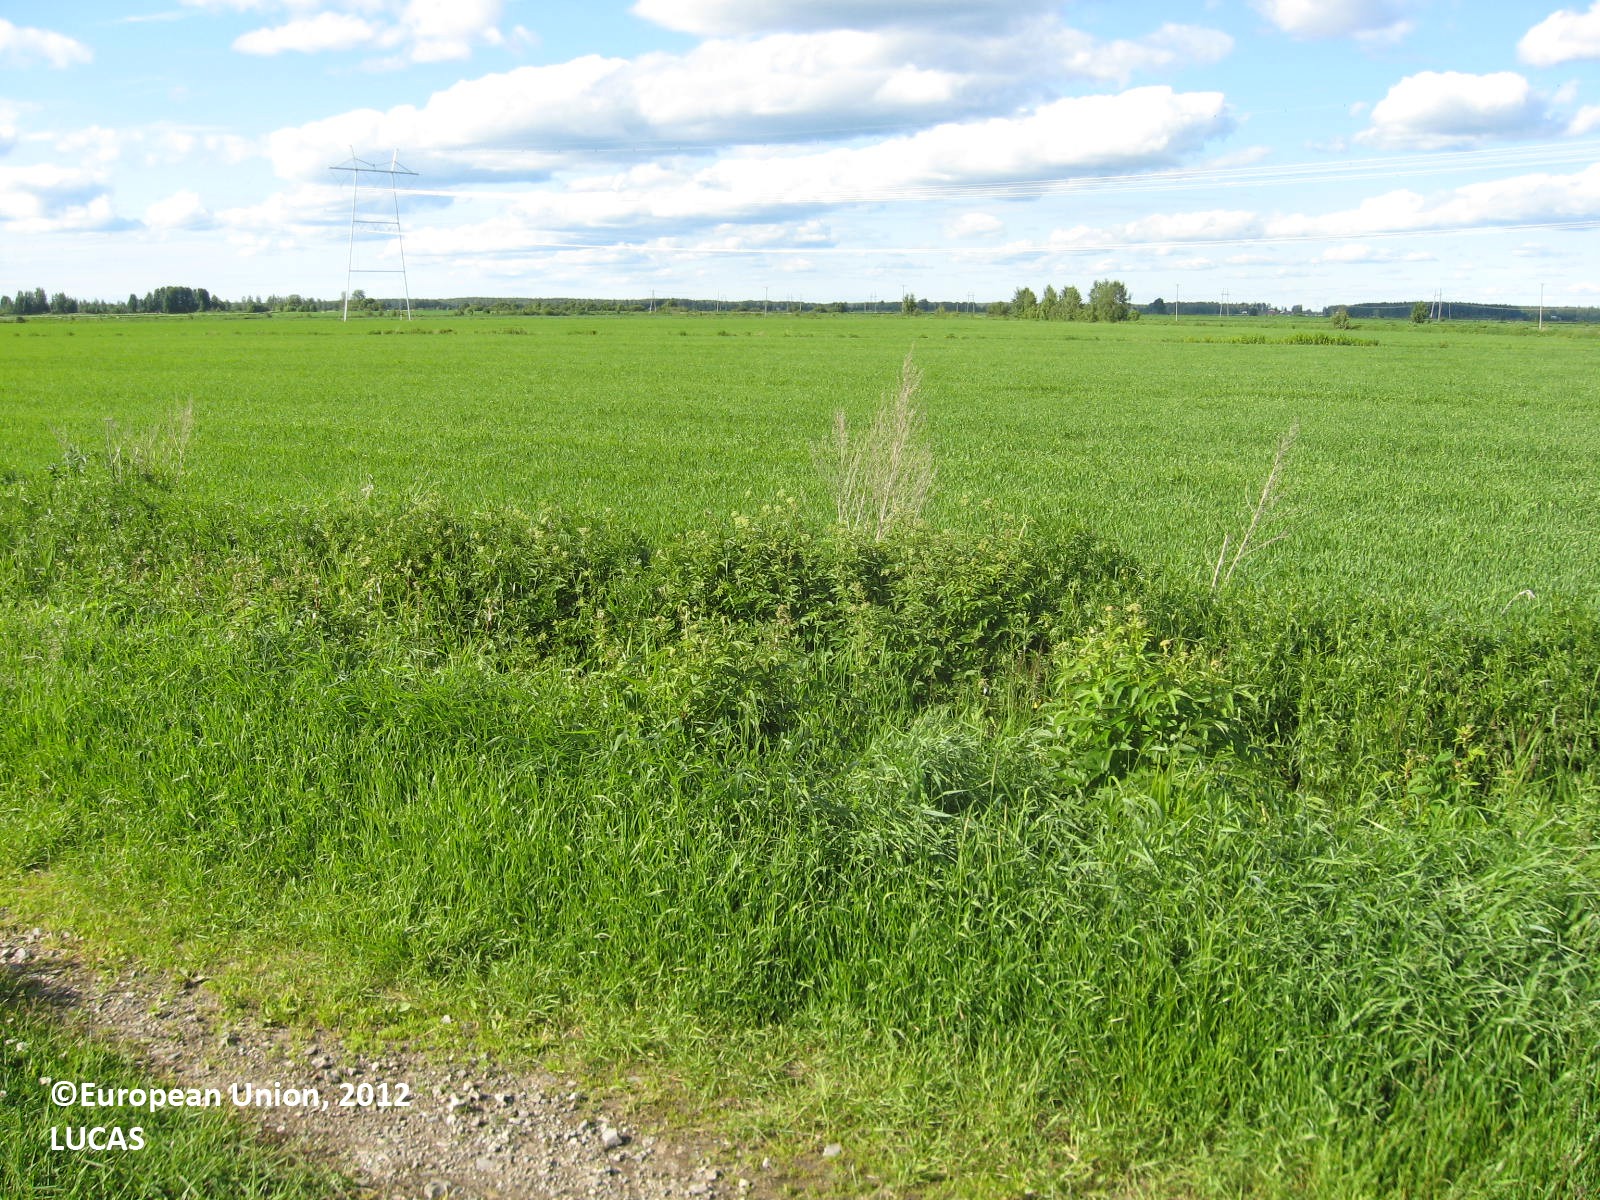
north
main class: Cropland
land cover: Barley
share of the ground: > 75 %
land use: Agriculture (excluding fallow land and kitchen gardens)
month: June
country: FI
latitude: 62.7862
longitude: 22.6985
